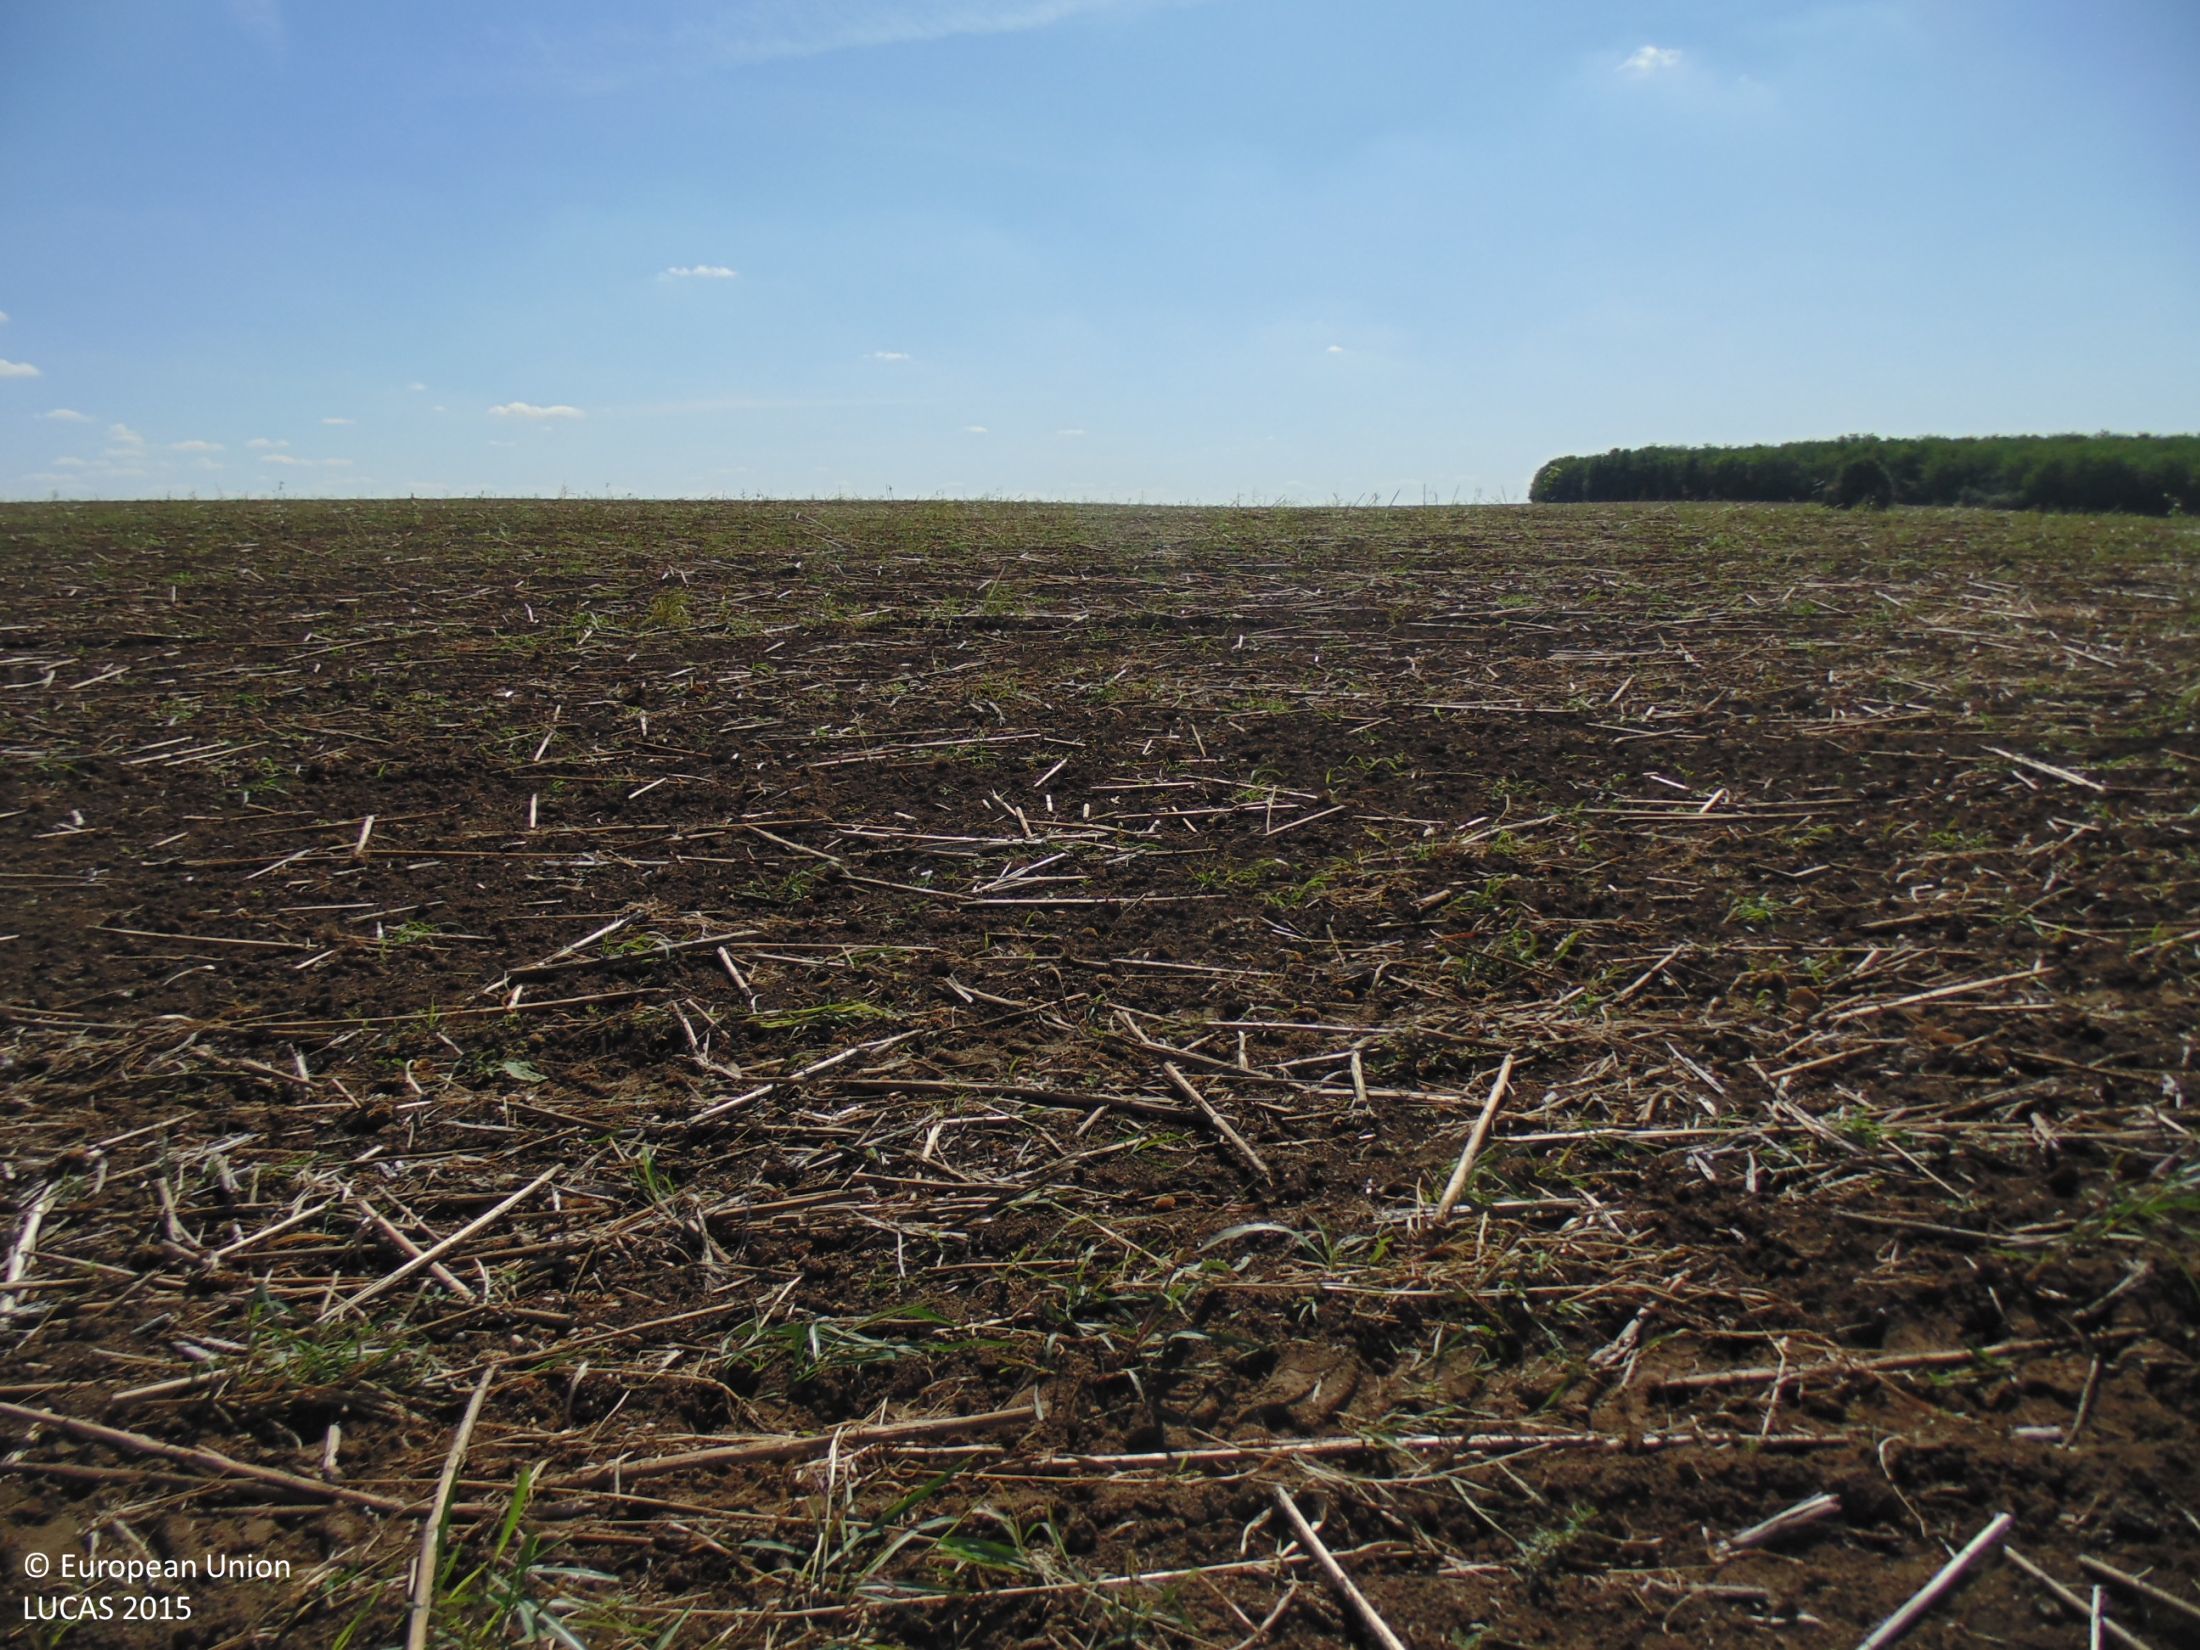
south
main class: Cropland
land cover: Sunflower
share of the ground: < 10 %
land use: Agriculture (excluding fallow land and kitchen gardens)
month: September
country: BG
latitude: 44.0852
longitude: 26.9452
